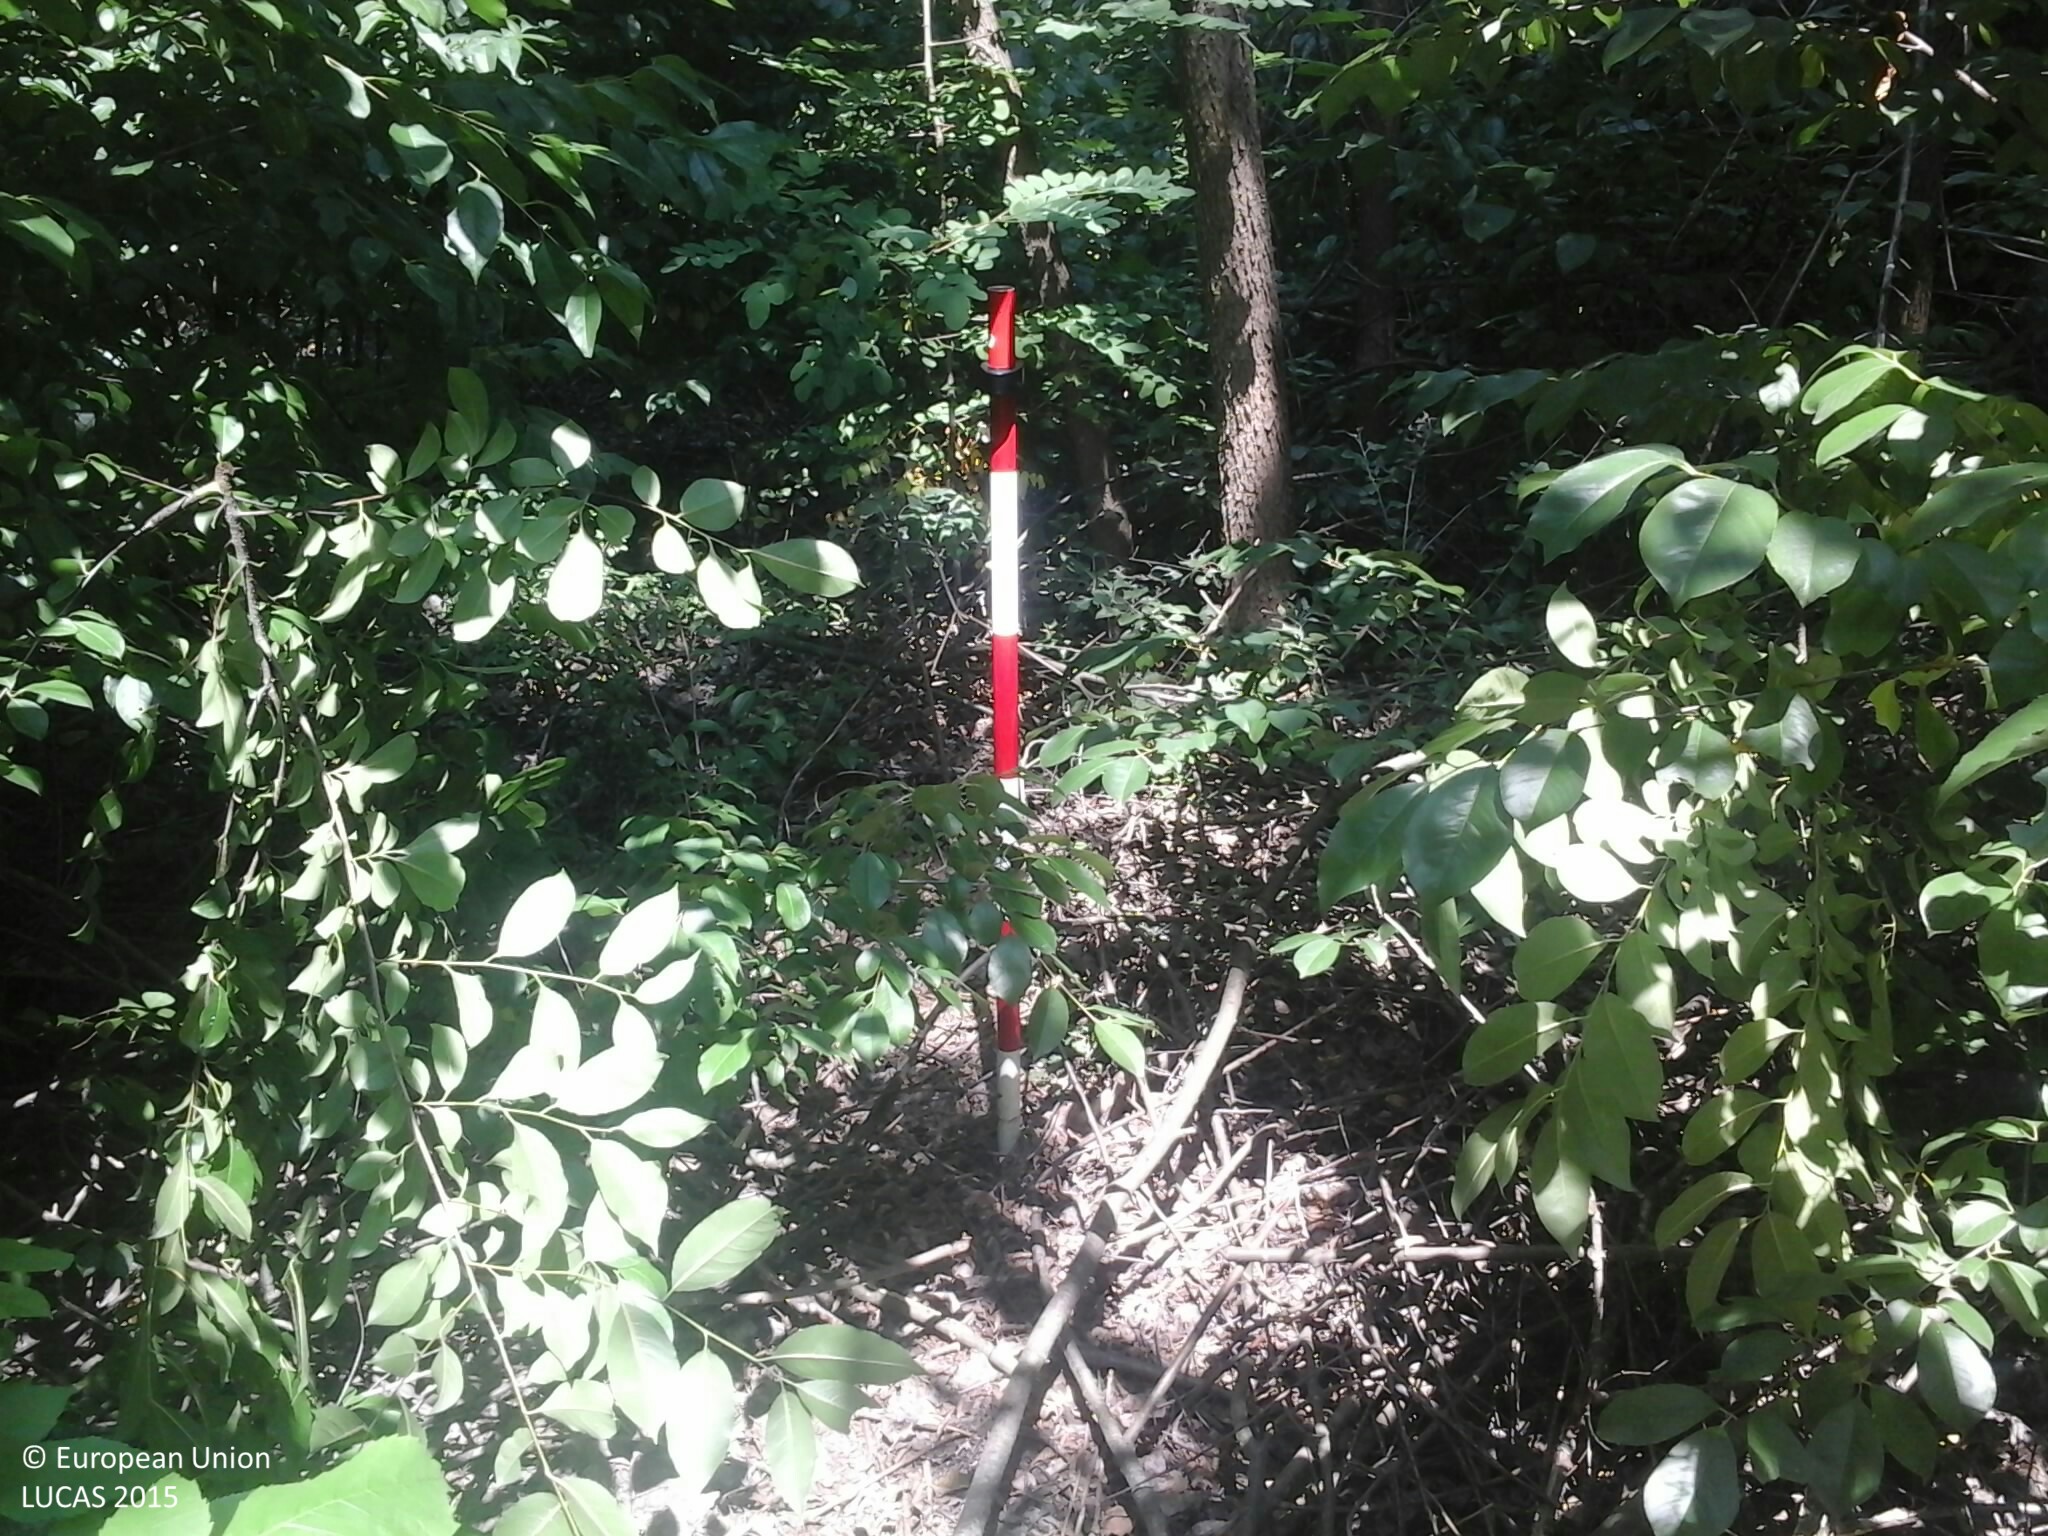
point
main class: Woodland
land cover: Broadleaved woodland
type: mesophytic deciduous forest
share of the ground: > 75 %
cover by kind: broadleaved forest trees 95 %, herbaceous plants 5 %
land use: Forestry
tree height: > 5 m
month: July
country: HU
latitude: 47.6689
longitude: 22.0505
